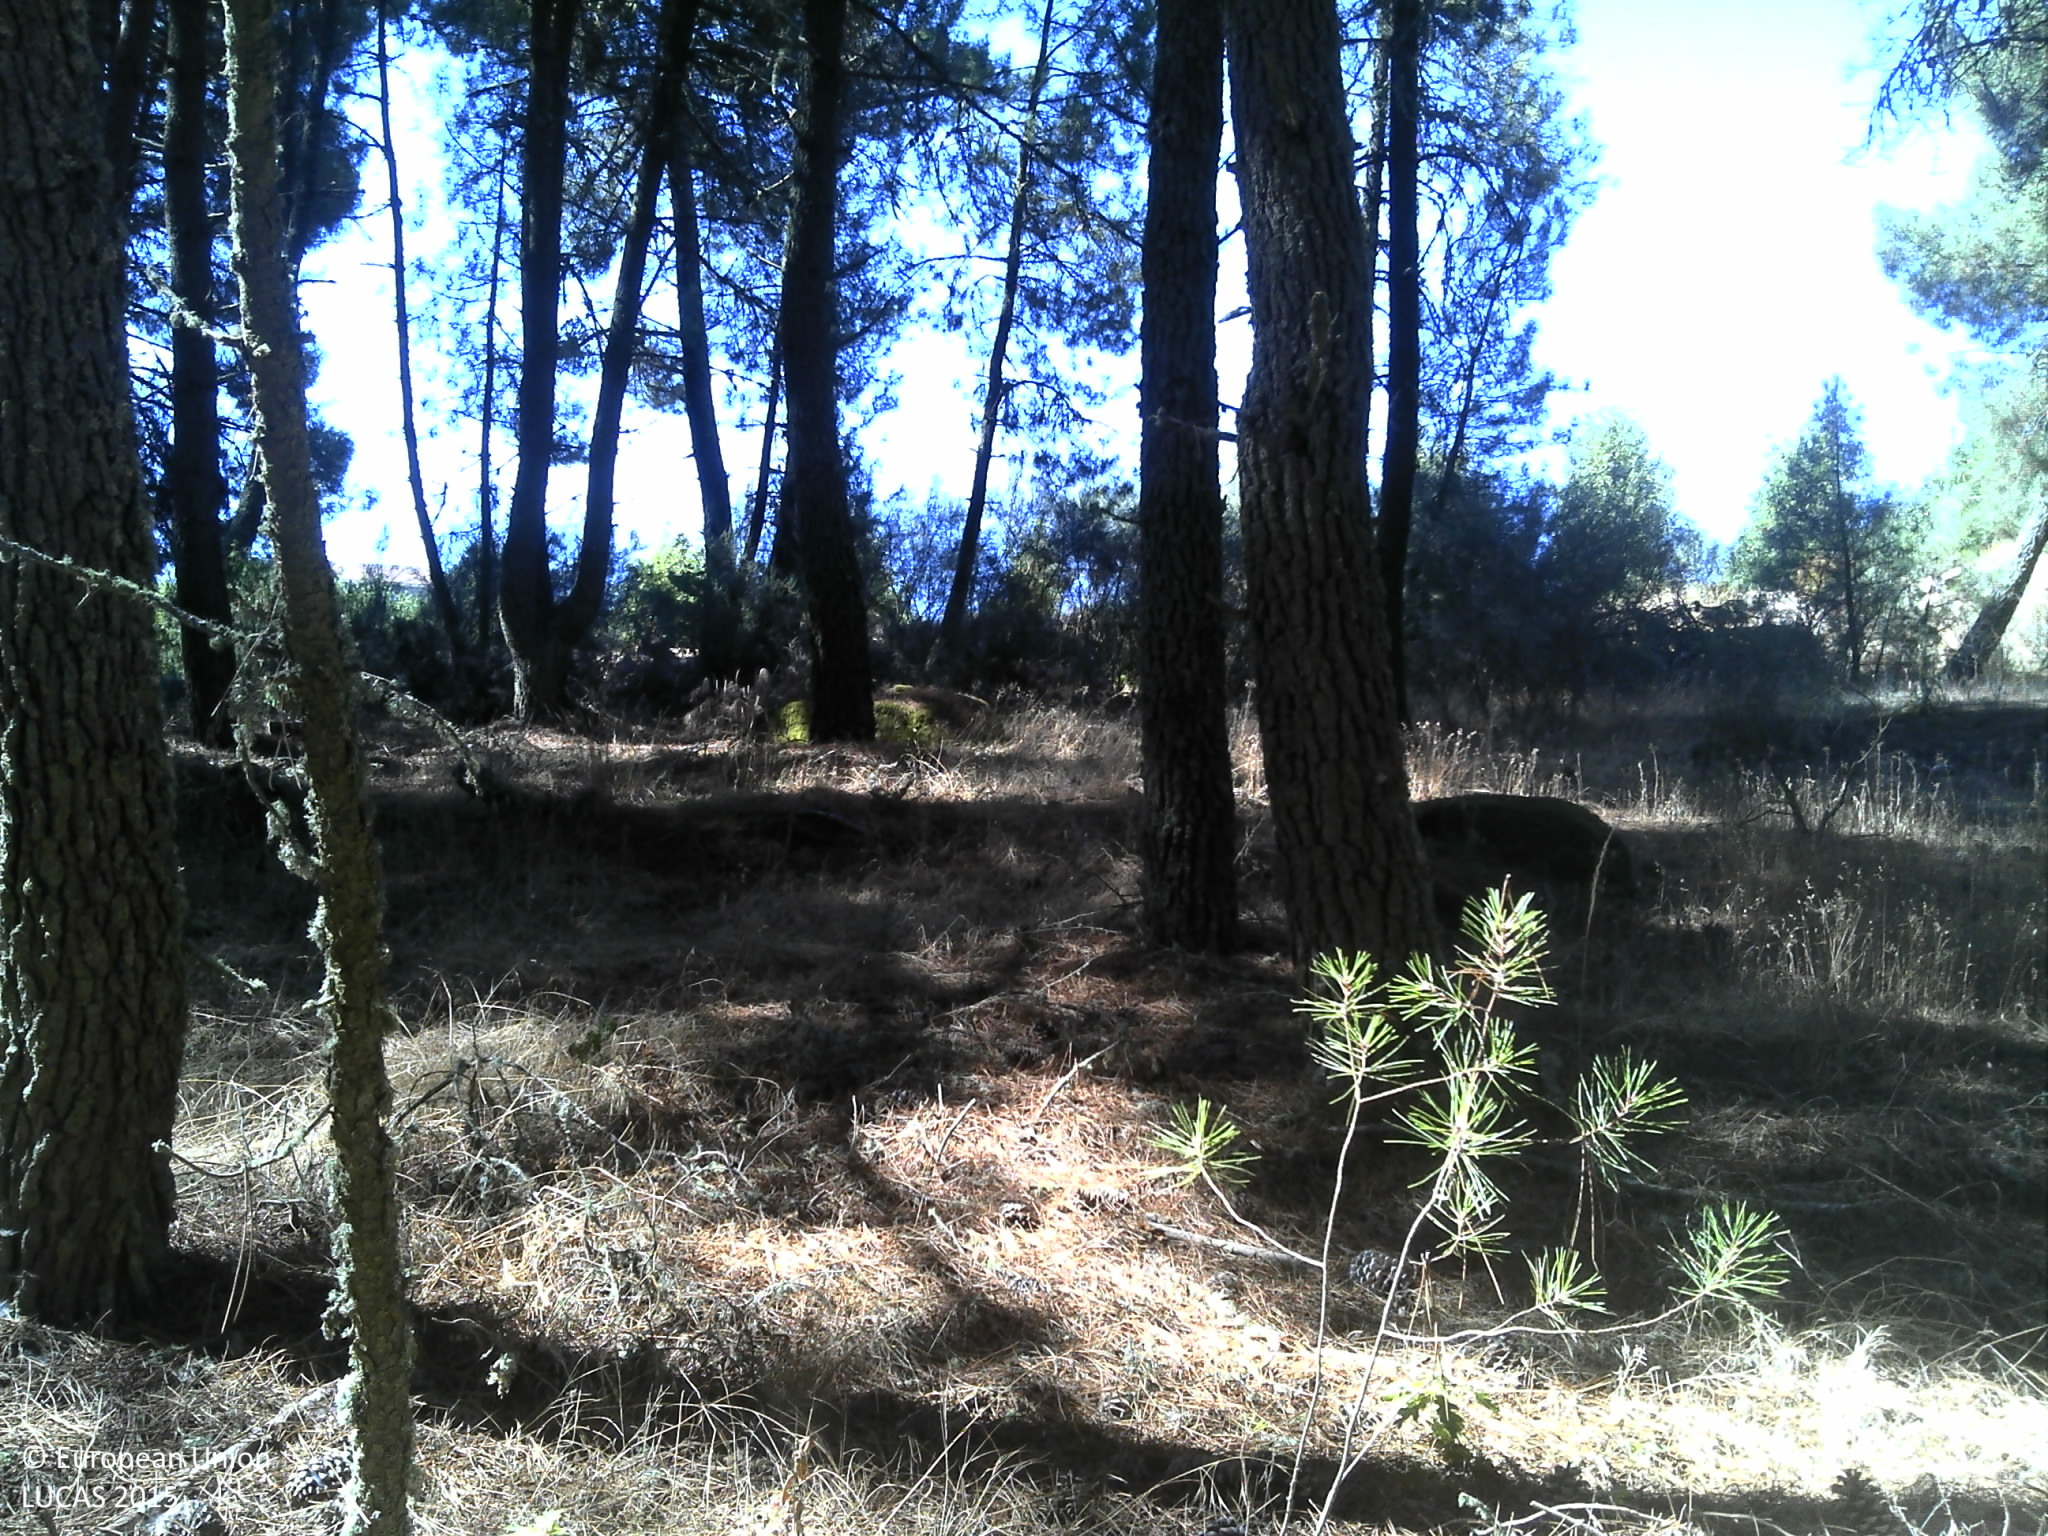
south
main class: Woodland
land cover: Pine dominated coniferous woodland
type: coniferous forest of the mediterranean region
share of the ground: < 10 %
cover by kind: unconsolidated bare surface 75 %, coniferous forest trees 20 %, shrubs 5 %
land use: Forestry
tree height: > 5 m
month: July
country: PT
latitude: 41.2285
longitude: -7.2844
